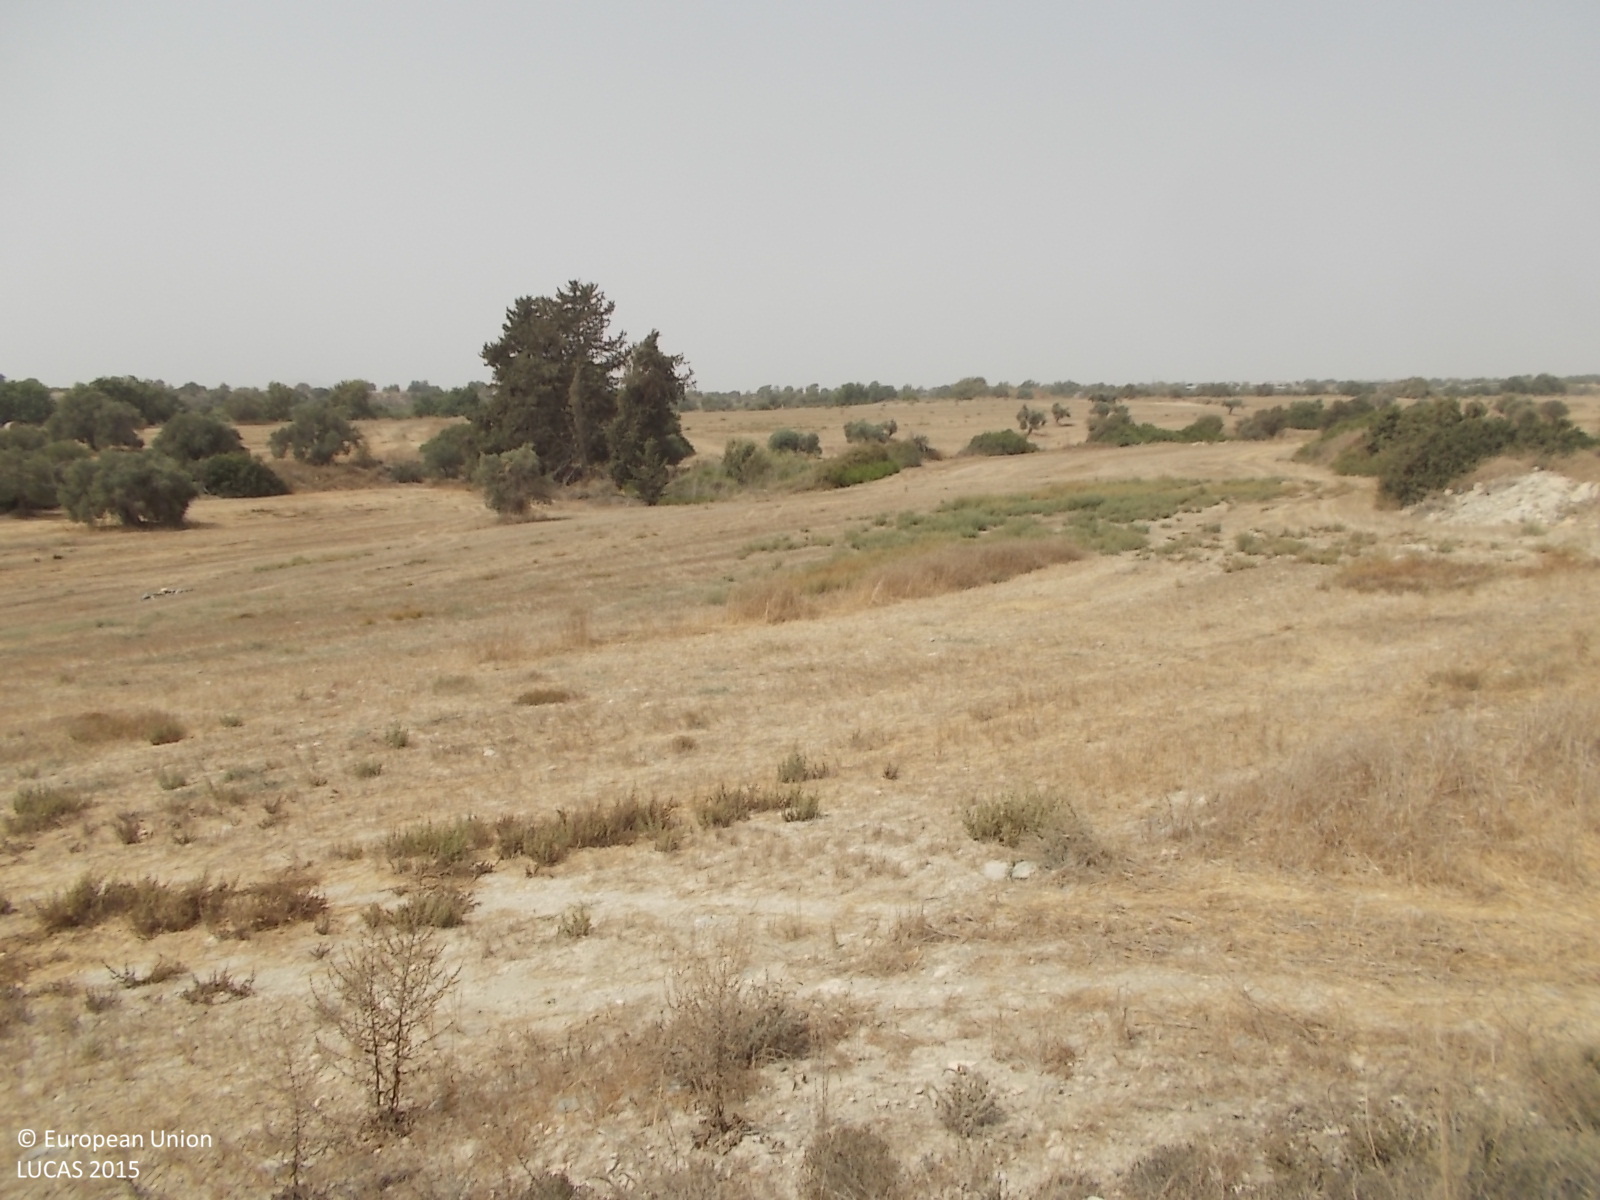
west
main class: Shrubland
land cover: Shrubland with sparse tree cover
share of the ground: 50 - 75 %
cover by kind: shrubs 55 %, herbaceous plants 20 %, unconsolidated bare surface 15 %, broadleaved forest trees 5 %, consolidated bare surface 5 %
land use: Semi-natural and natural areas not in use
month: April
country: CY
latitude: 34.8133
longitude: 33.5057
